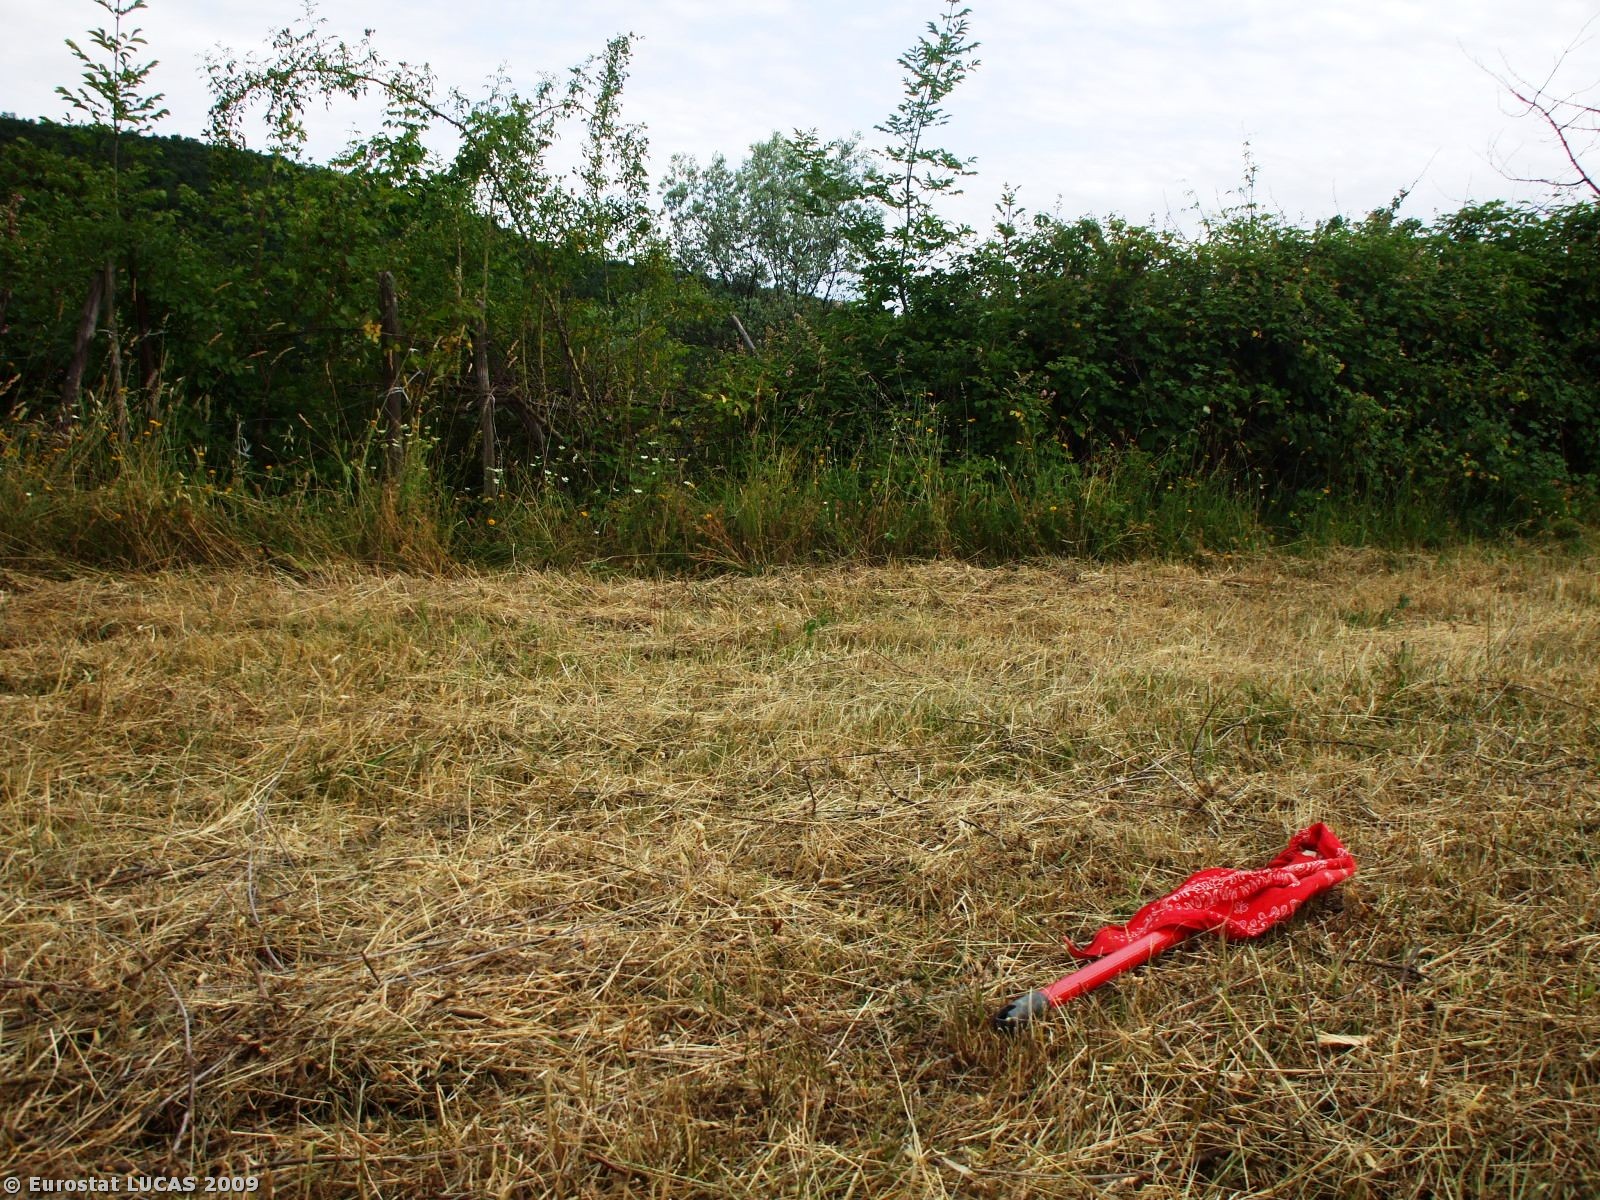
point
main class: Cropland
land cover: Olive groves
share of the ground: 10 - 25 %
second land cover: Grassland with sparse tree/shrub cover
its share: > 75 %
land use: Agriculture (excluding fallow land and kitchen gardens)
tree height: < 5 m
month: June
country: IT
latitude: 43.3989
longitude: 11.6622
